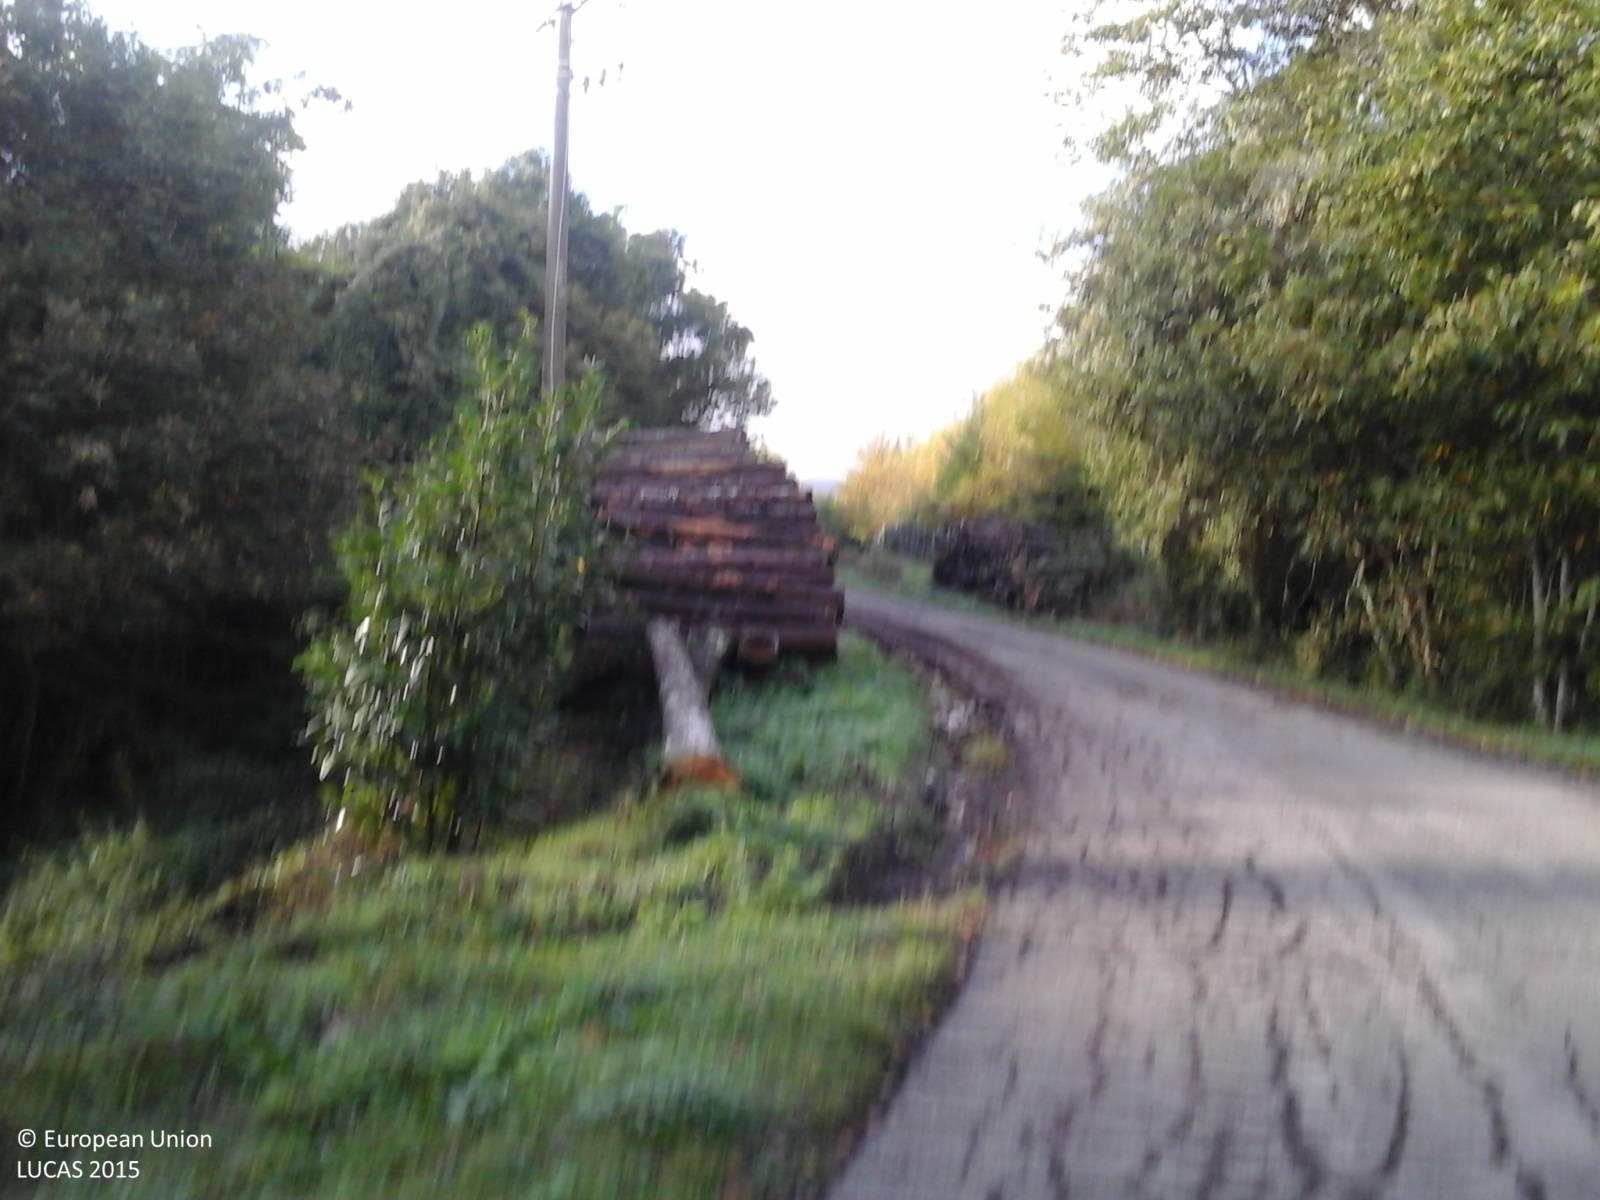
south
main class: Woodland
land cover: Other coniferous woodland
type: alpine coniferous forest
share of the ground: > 75 %
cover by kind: coniferous forest trees 100 %
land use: Forestry
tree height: > 5 m
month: October
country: IT
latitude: 43.7060
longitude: 11.6462
